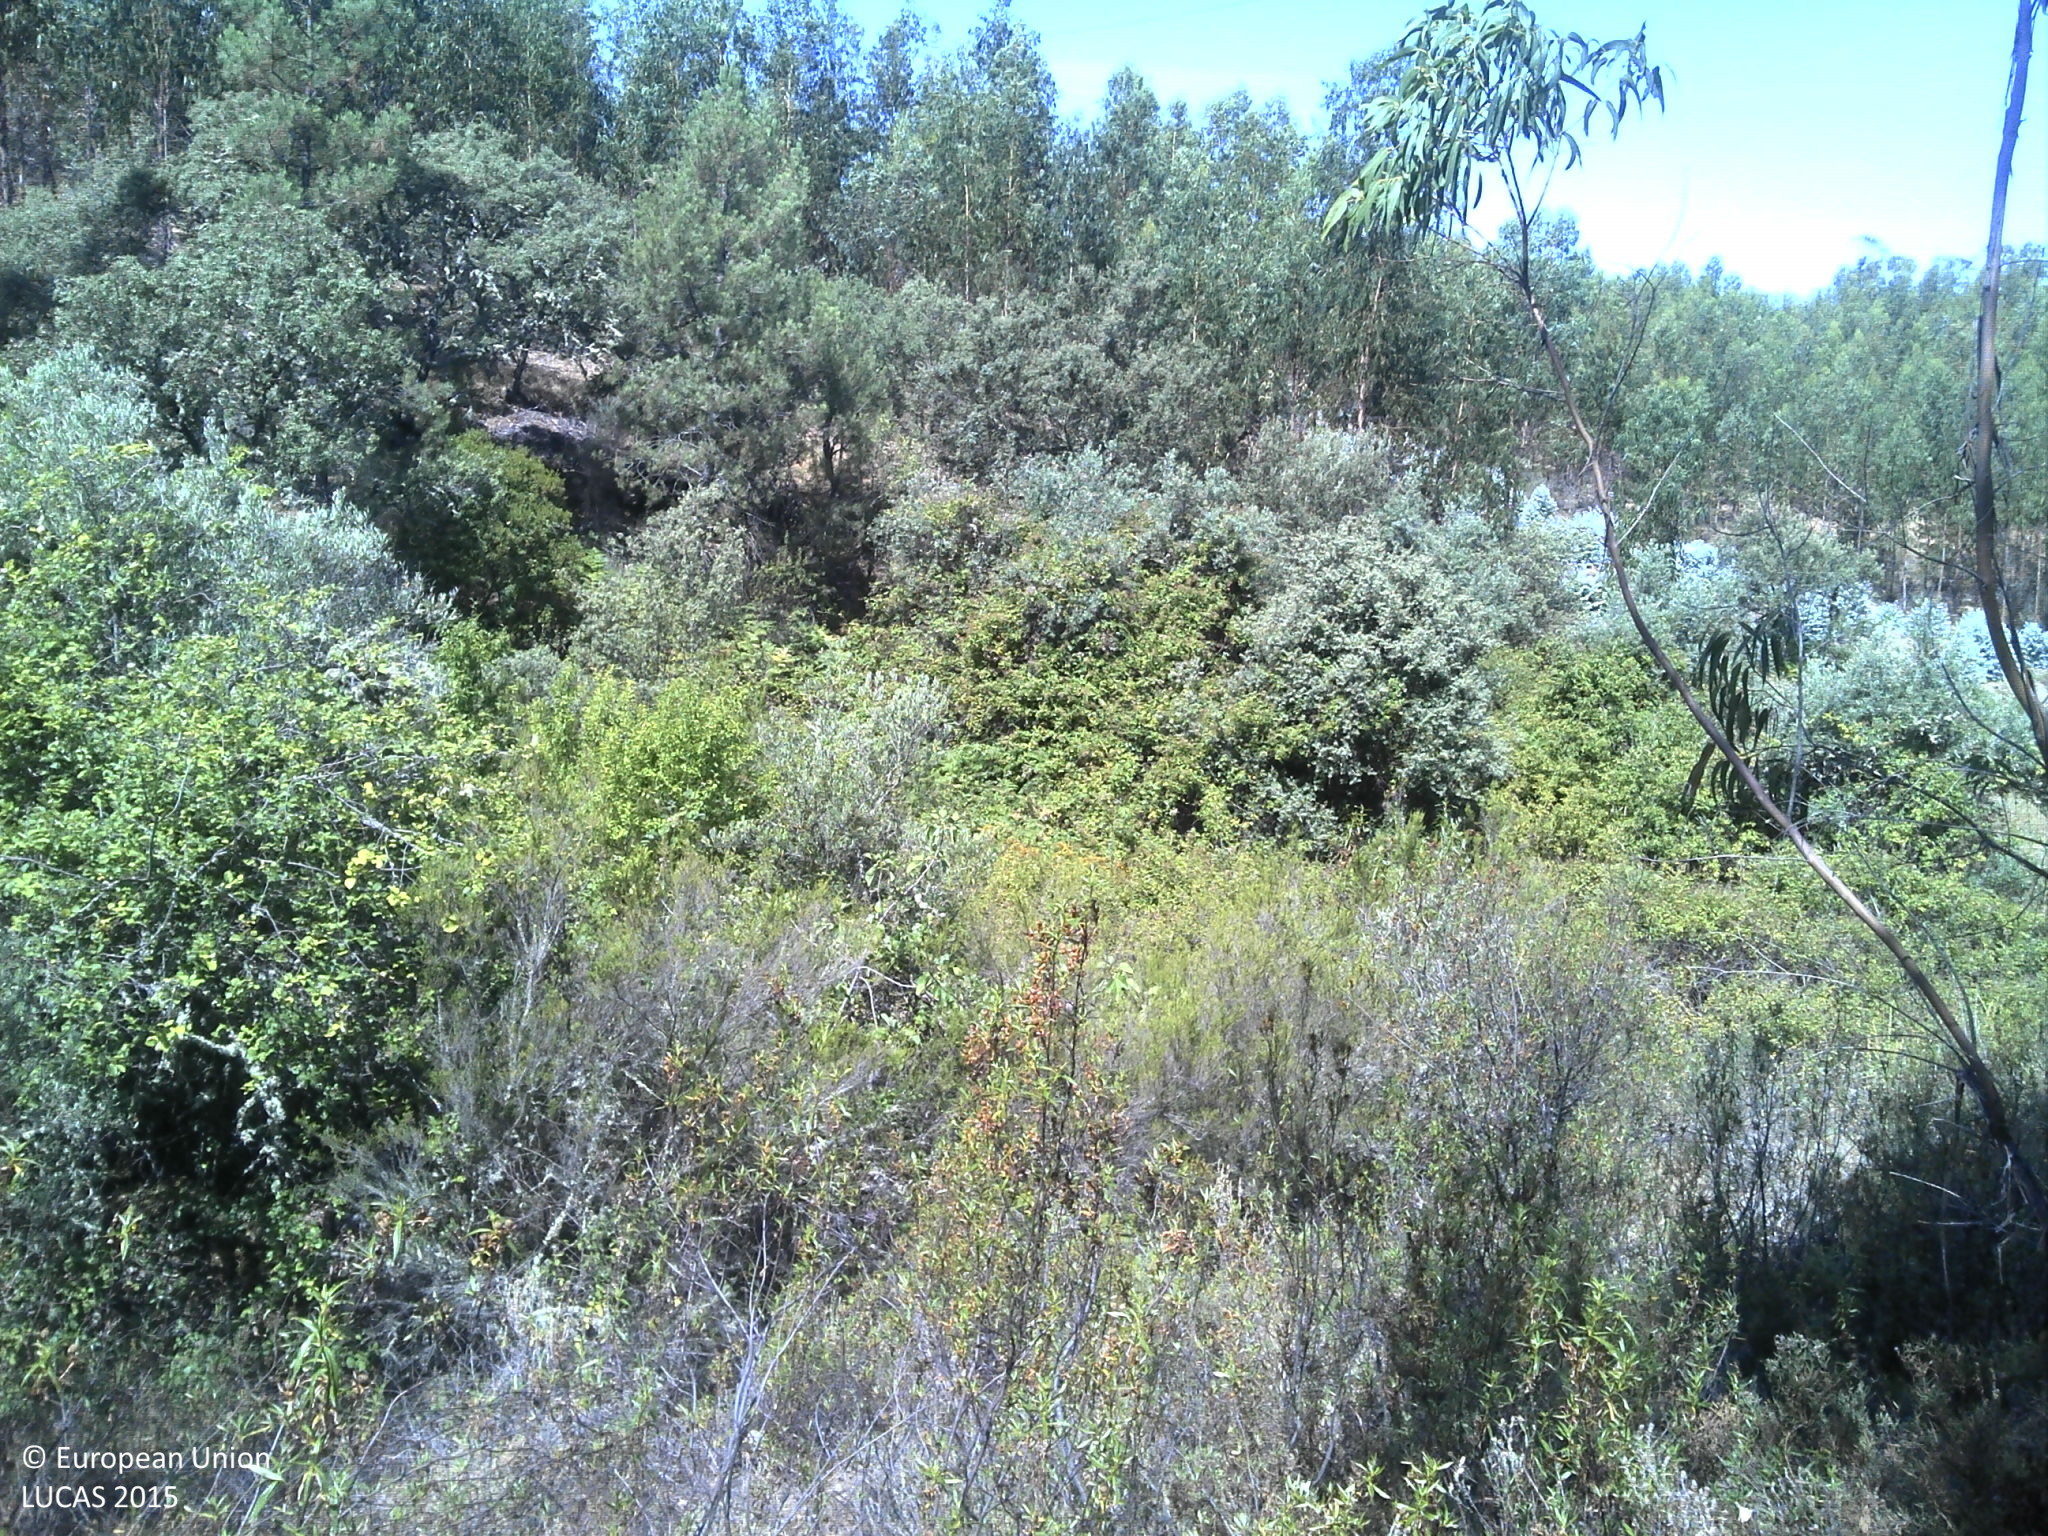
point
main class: Woodland
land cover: Broadleaved woodland
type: exotic forest
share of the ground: 50 - 75 %
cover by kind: broadleaved forest trees 60 %, shrubs 20 %, unconsolidated bare surface 20 %
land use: Forestry
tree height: > 5 m
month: July
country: PT
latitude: 39.7699
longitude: -7.6003
